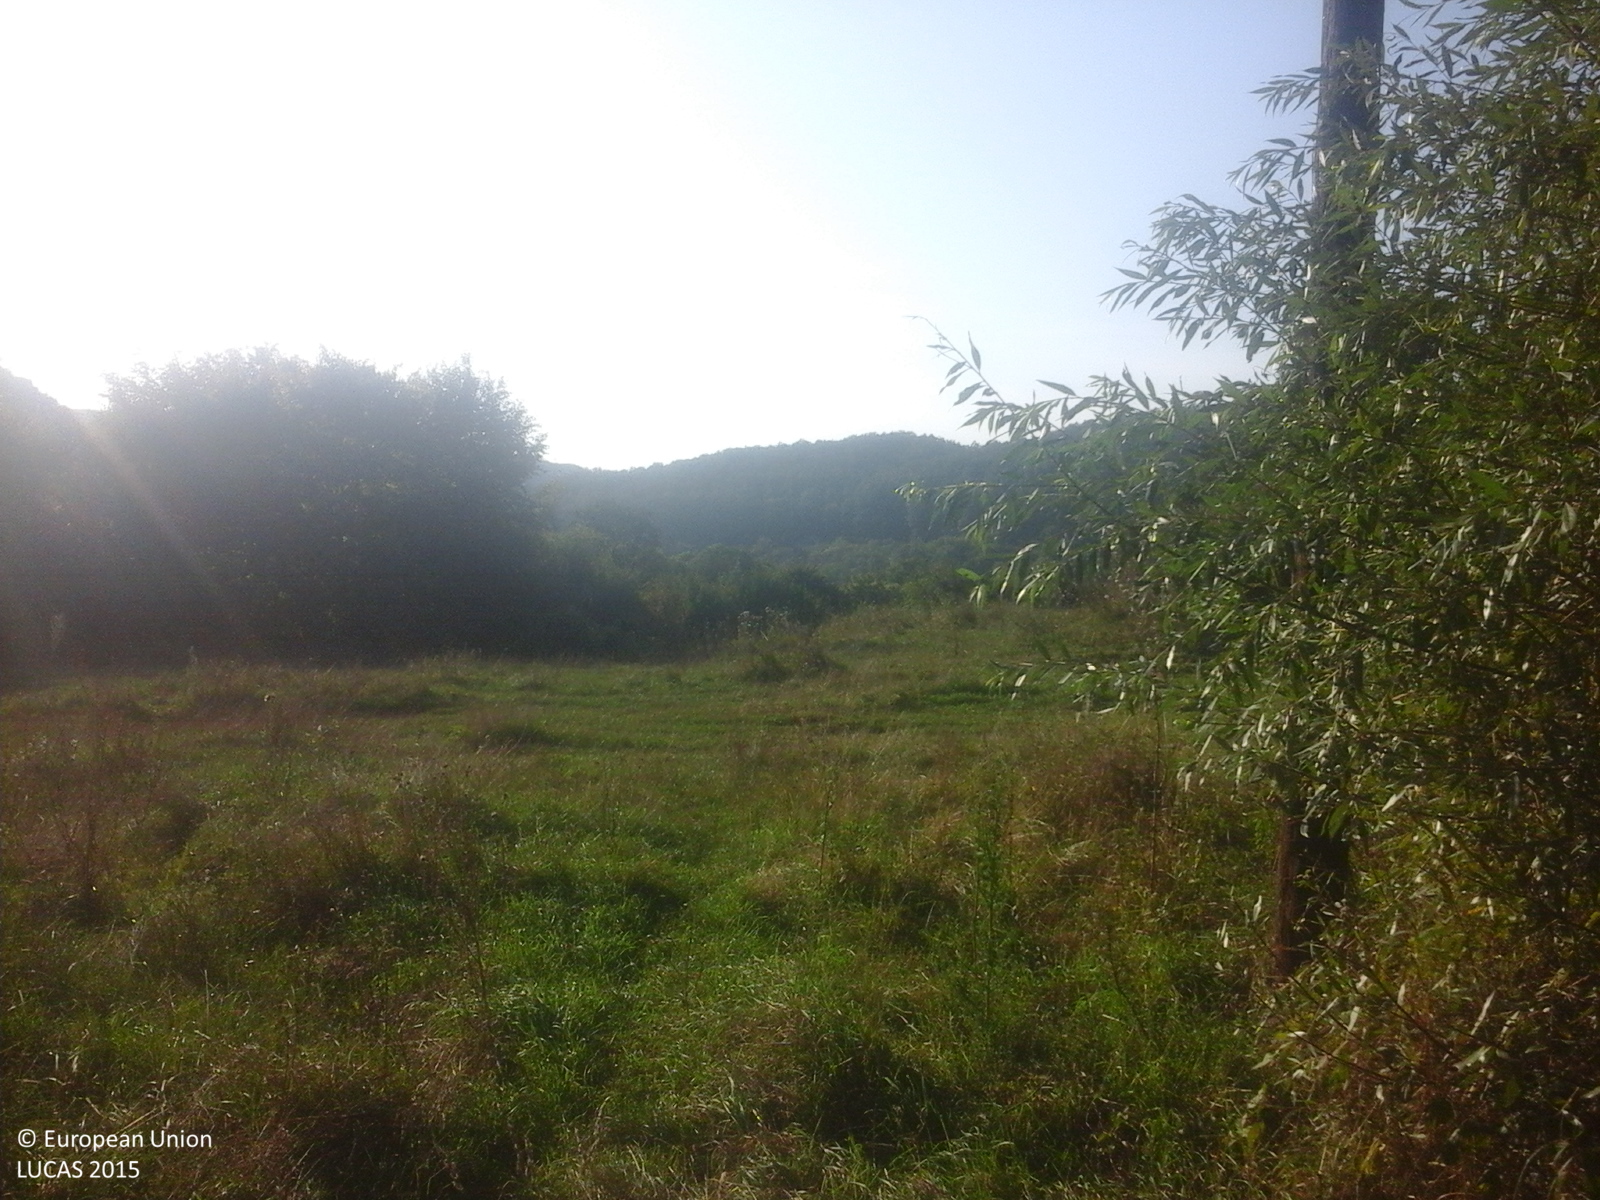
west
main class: Woodland
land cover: Broadleaved woodland
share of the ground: > 75 %
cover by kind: broadleaved forest trees 100 %
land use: Semi-natural and natural areas not in use
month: September
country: RO
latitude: 46.8867
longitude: 23.2816
